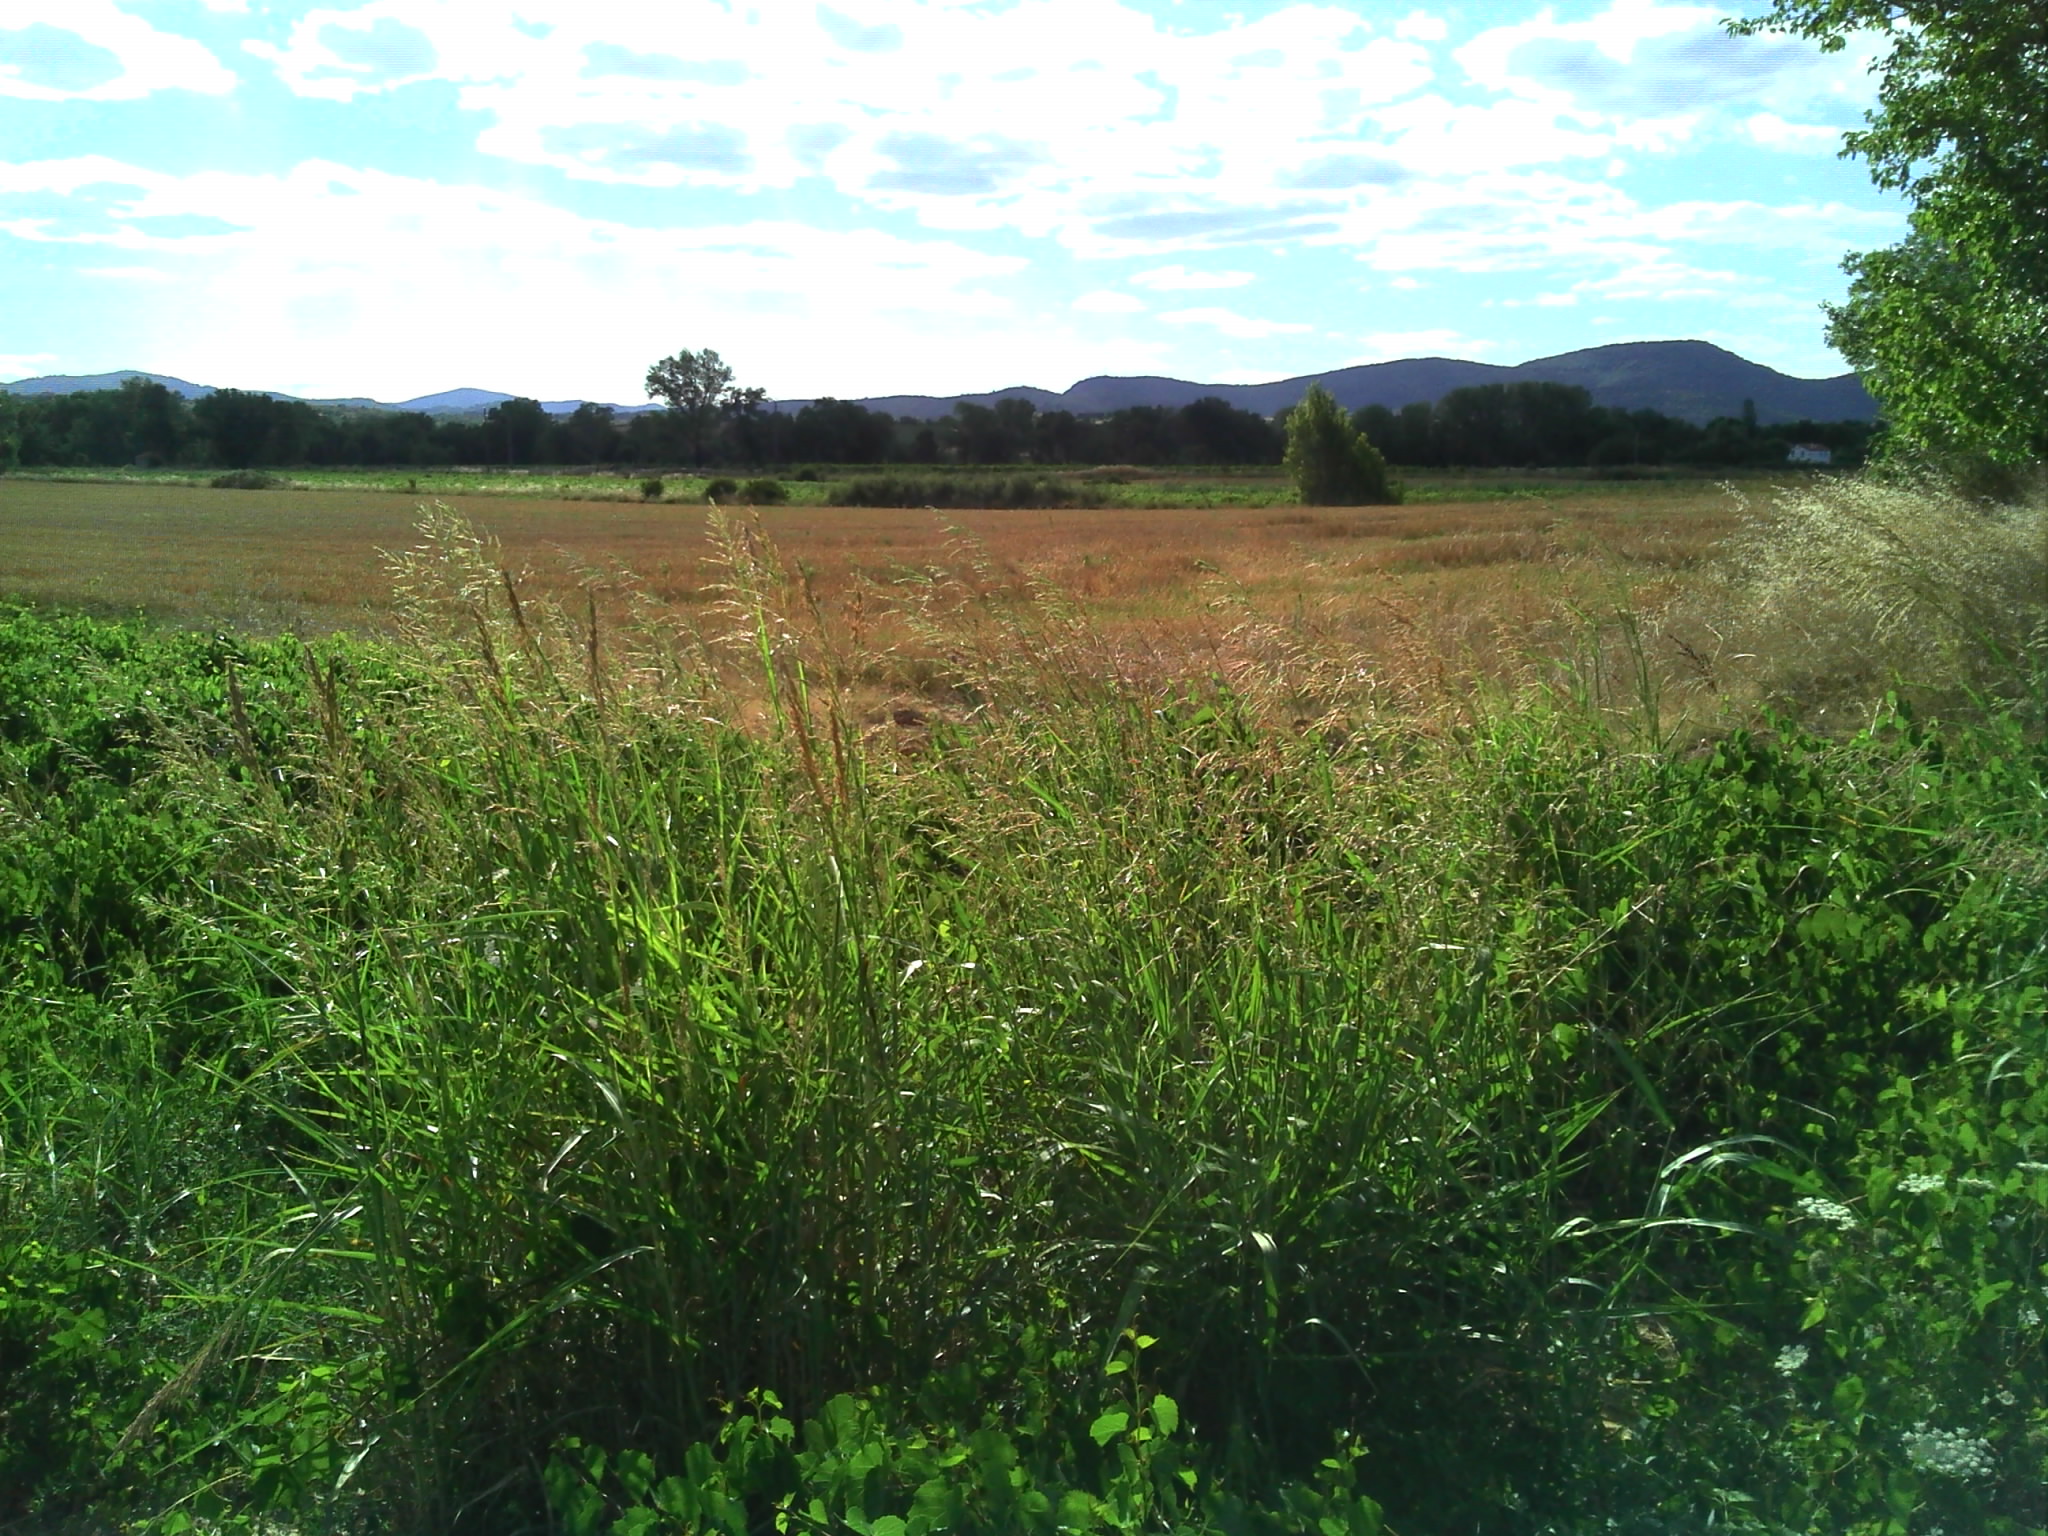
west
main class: Cropland
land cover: Vineyards
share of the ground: > 75 %
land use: Abandoned areas
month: July
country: FR
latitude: 44.2652
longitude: 4.2825
